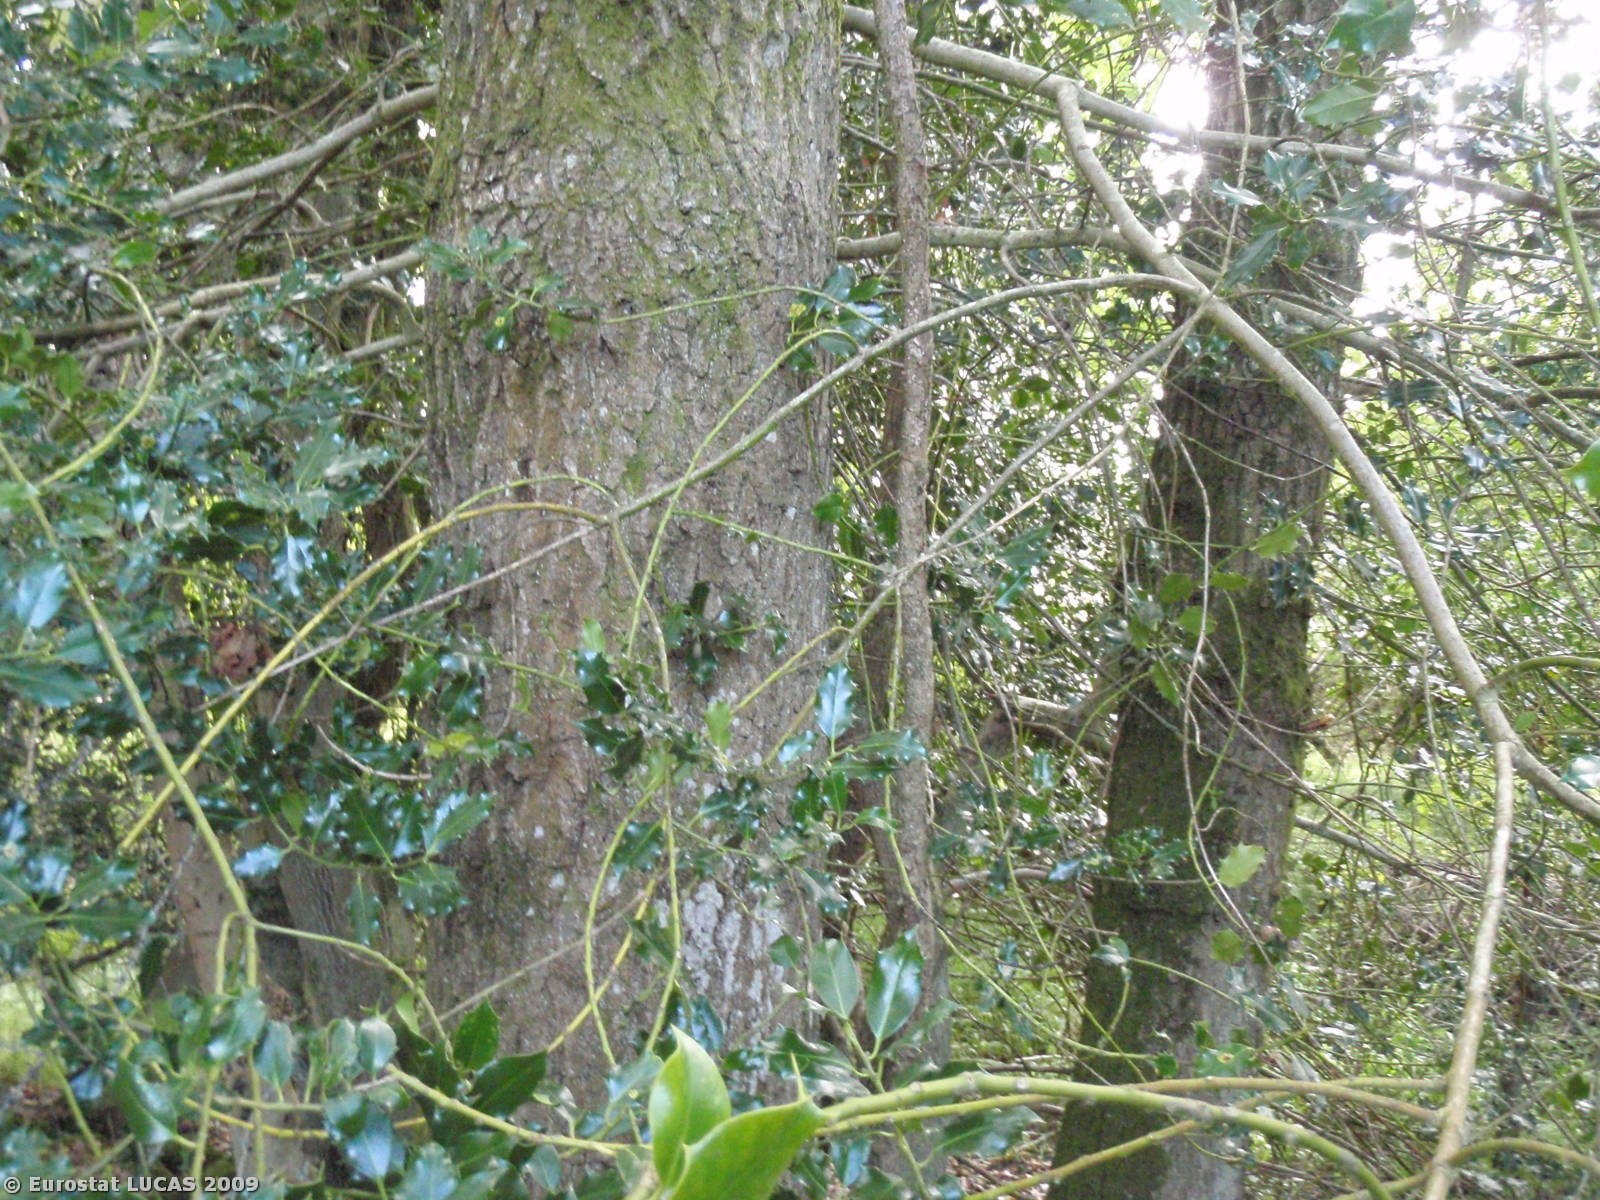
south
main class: Woodland
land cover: Broadleaved woodland
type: acidophilous oak and oak-birch forest
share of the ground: > 75 %
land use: Unused
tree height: > 5 m
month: September
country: GB
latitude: 50.6469
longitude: -2.0947
